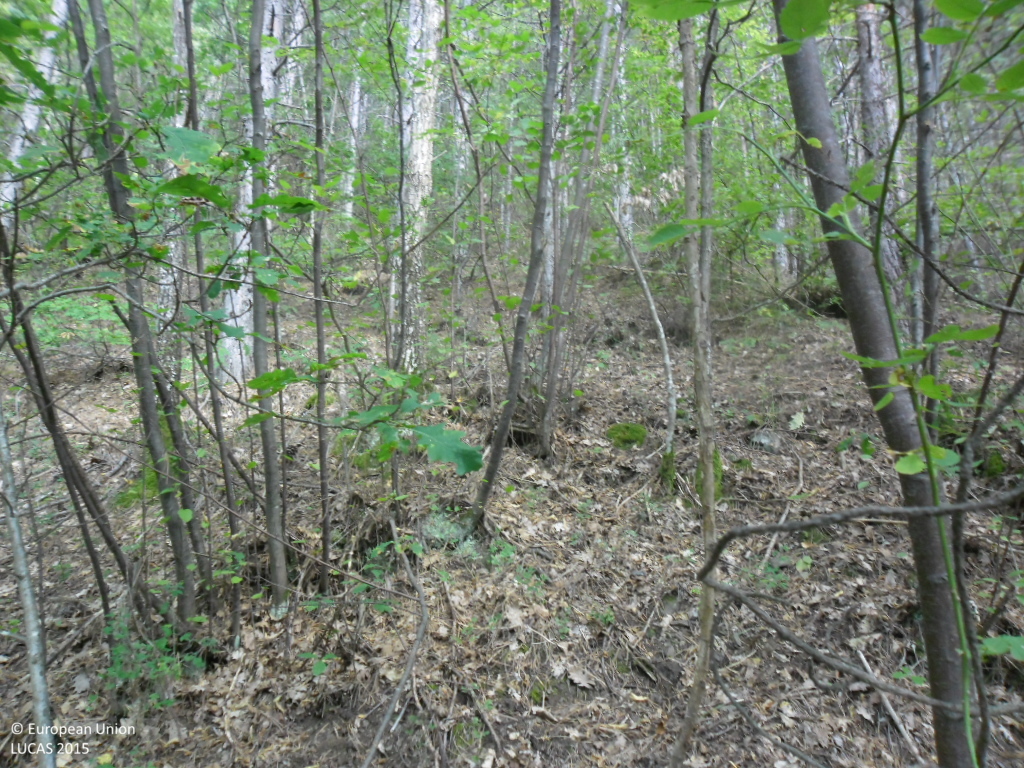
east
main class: Woodland
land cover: Pine dominated mixed woodland
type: hemiboreal forest and nemoral coniferous forest and mixed broadleaved-coniferous forest
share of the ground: > 75 %
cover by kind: coniferous forest trees 75 %, broadleaved forest trees 25 %
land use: Forestry
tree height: > 5 m
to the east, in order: Pine dominated mixed woodland; Broadleaved woodland; Pine dominated coniferous woodland; Pine dominated mixed woodland
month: September
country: BG
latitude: 41.8080
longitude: 23.0329
